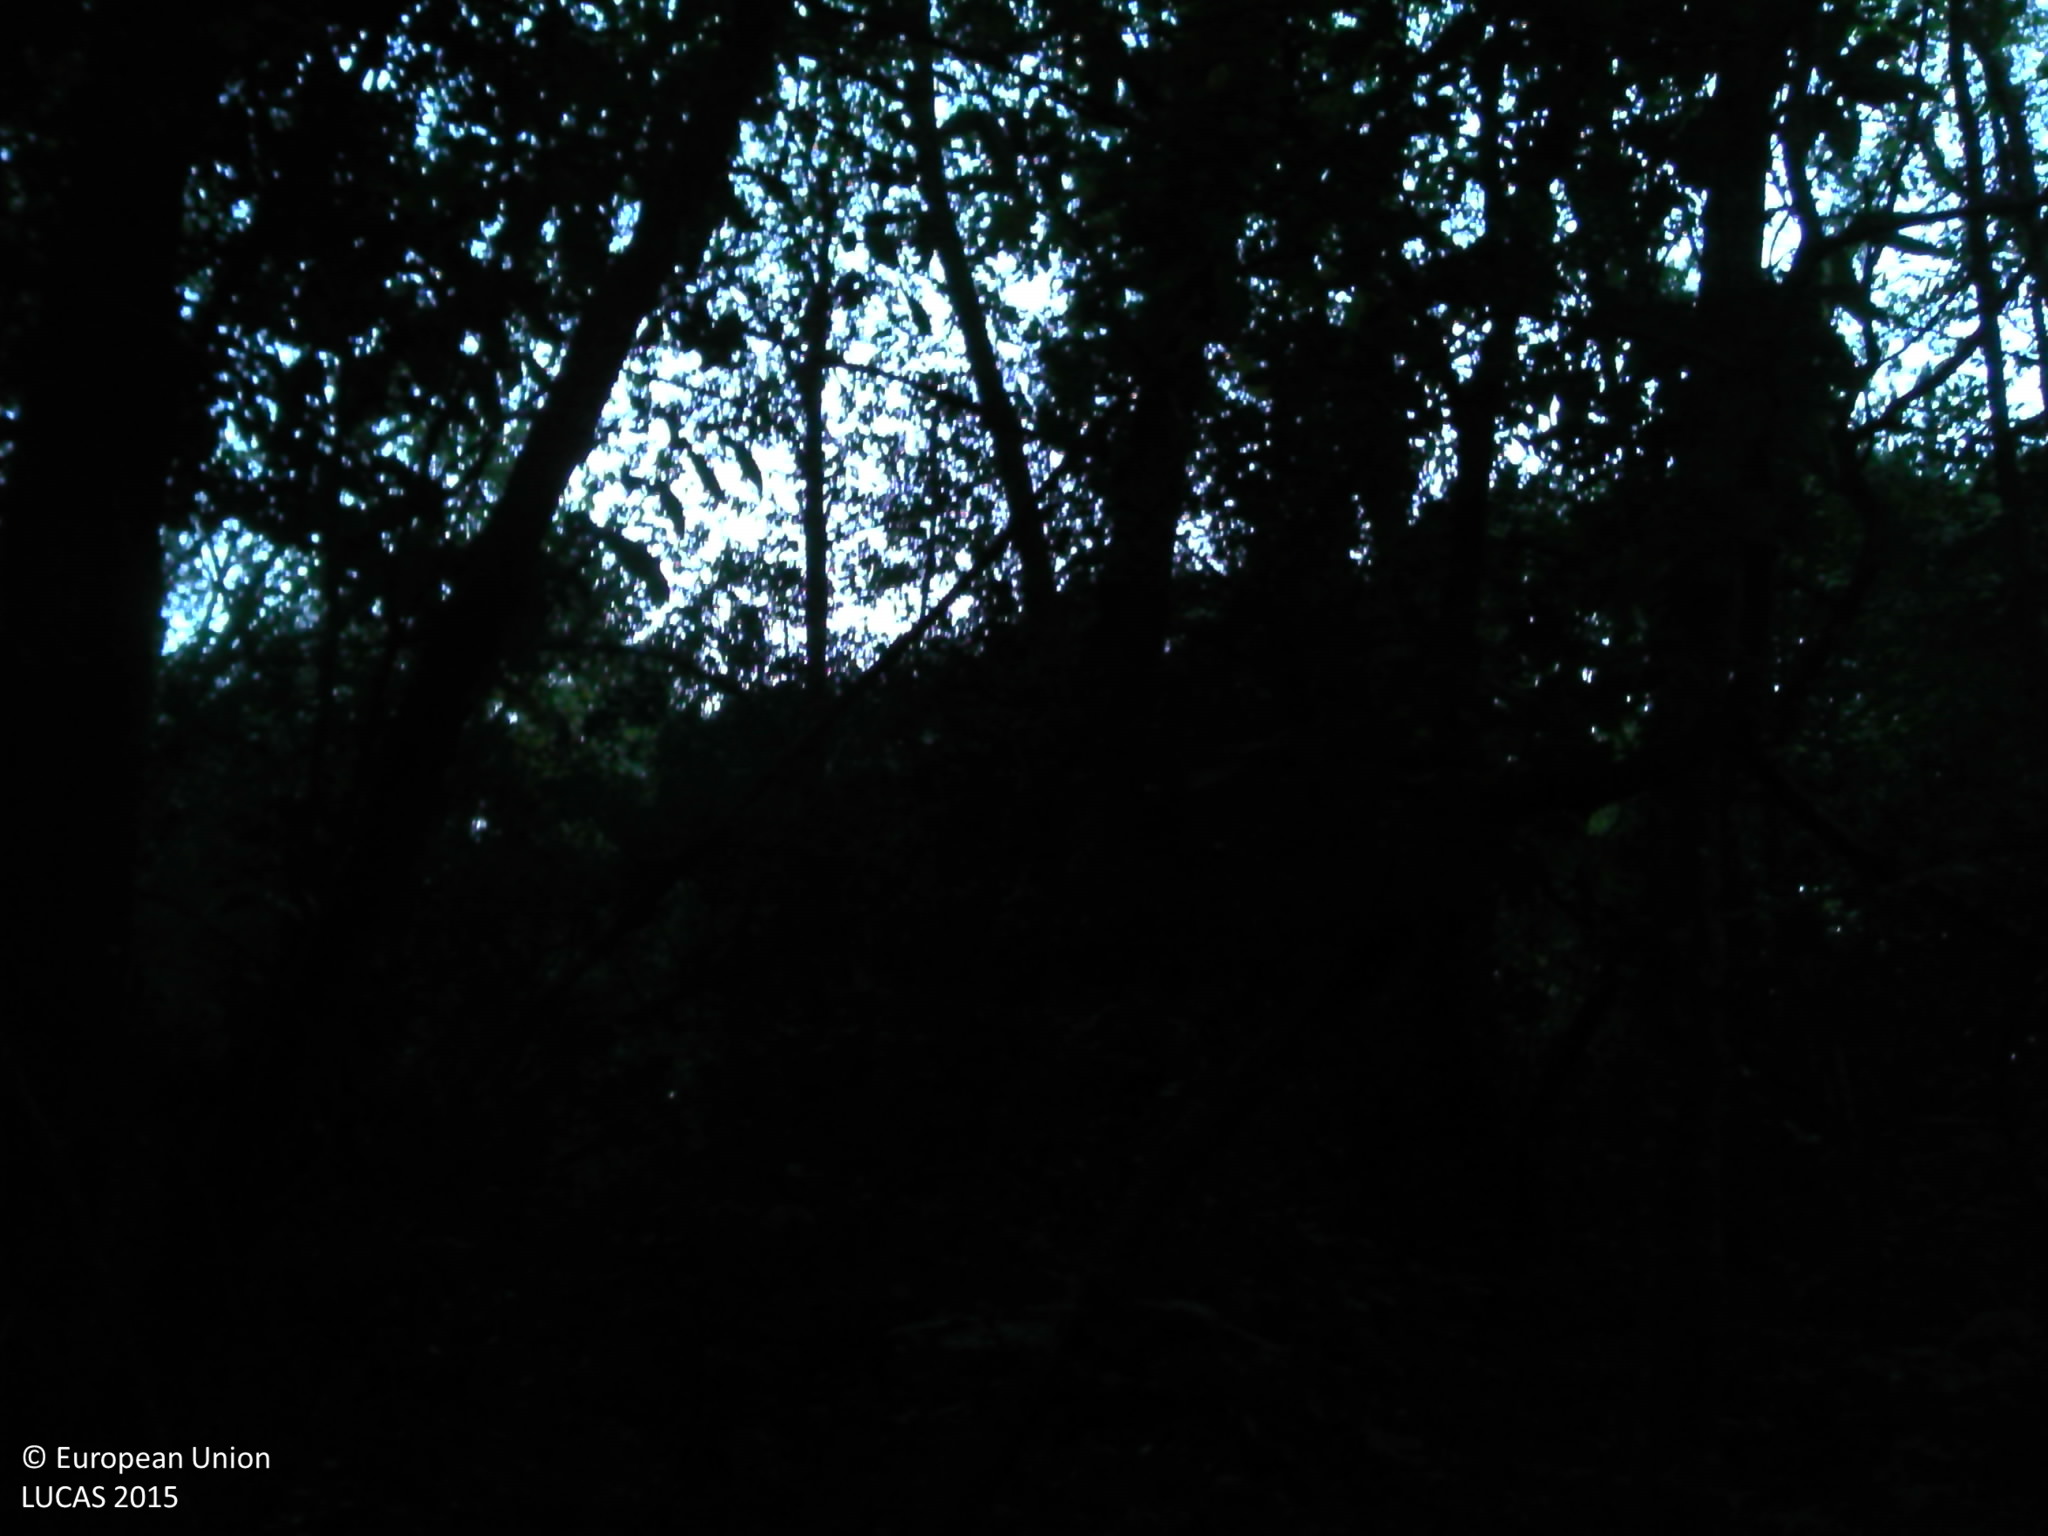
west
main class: Woodland
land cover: Broadleaved woodland
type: acidophilous oak and oak-birch forest
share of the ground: > 75 %
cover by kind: broadleaved forest trees 75 %, shrubs 15 %, herbaceous plants 5 %, lichens and mosses 5 %
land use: Forestry
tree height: > 5 m
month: September
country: FR
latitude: 43.4171
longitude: -0.4942
